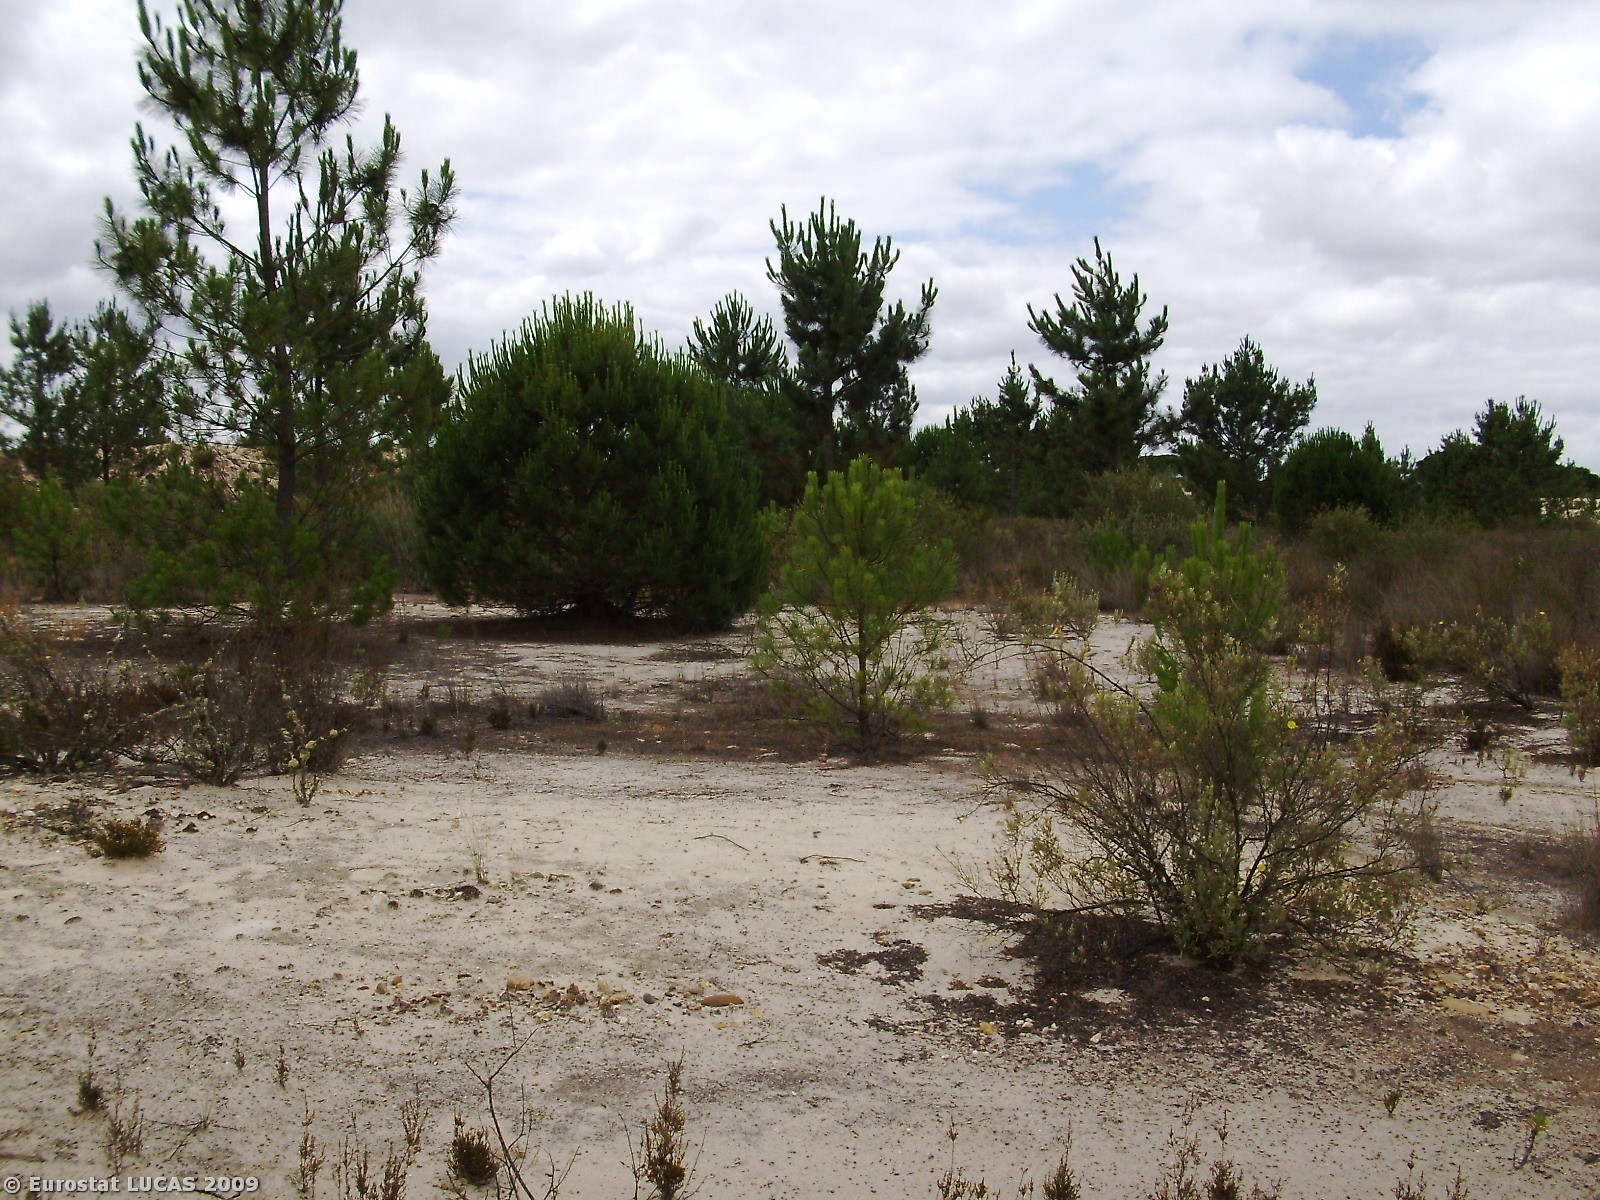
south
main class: Woodland
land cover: Coniferous woodland
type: coniferous forest of the mediterranean region
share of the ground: 25 - 50 %
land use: Forestry
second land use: Mining and quarrying
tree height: > 5 m
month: June
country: PT
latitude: 38.2625
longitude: -8.5296
